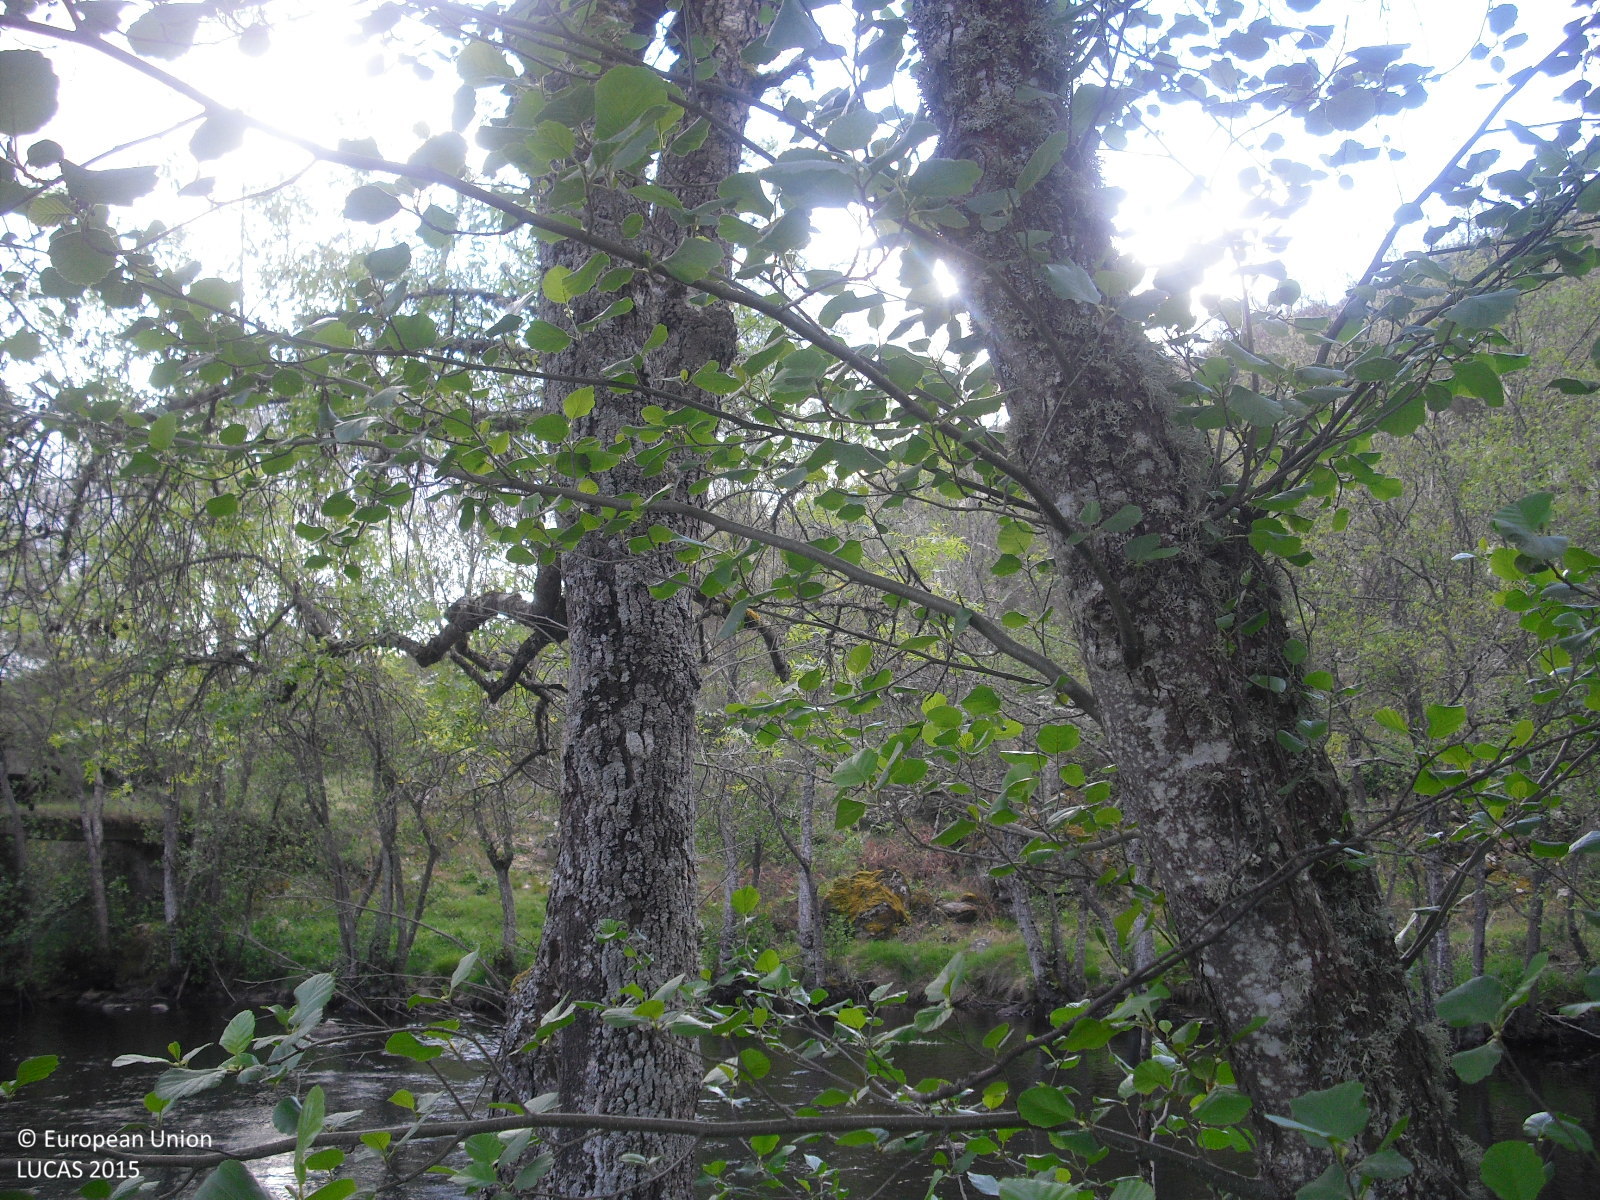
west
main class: Woodland
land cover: Broadleaved woodland
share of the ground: 25 - 50 %
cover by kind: broadleaved forest trees 30 %, herbaceous plants 30 %, shrubs 20 %, consolidated bare surface 20 %
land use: Amenities, museums, leisure
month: April
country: ES
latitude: 41.8865
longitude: -7.5240
